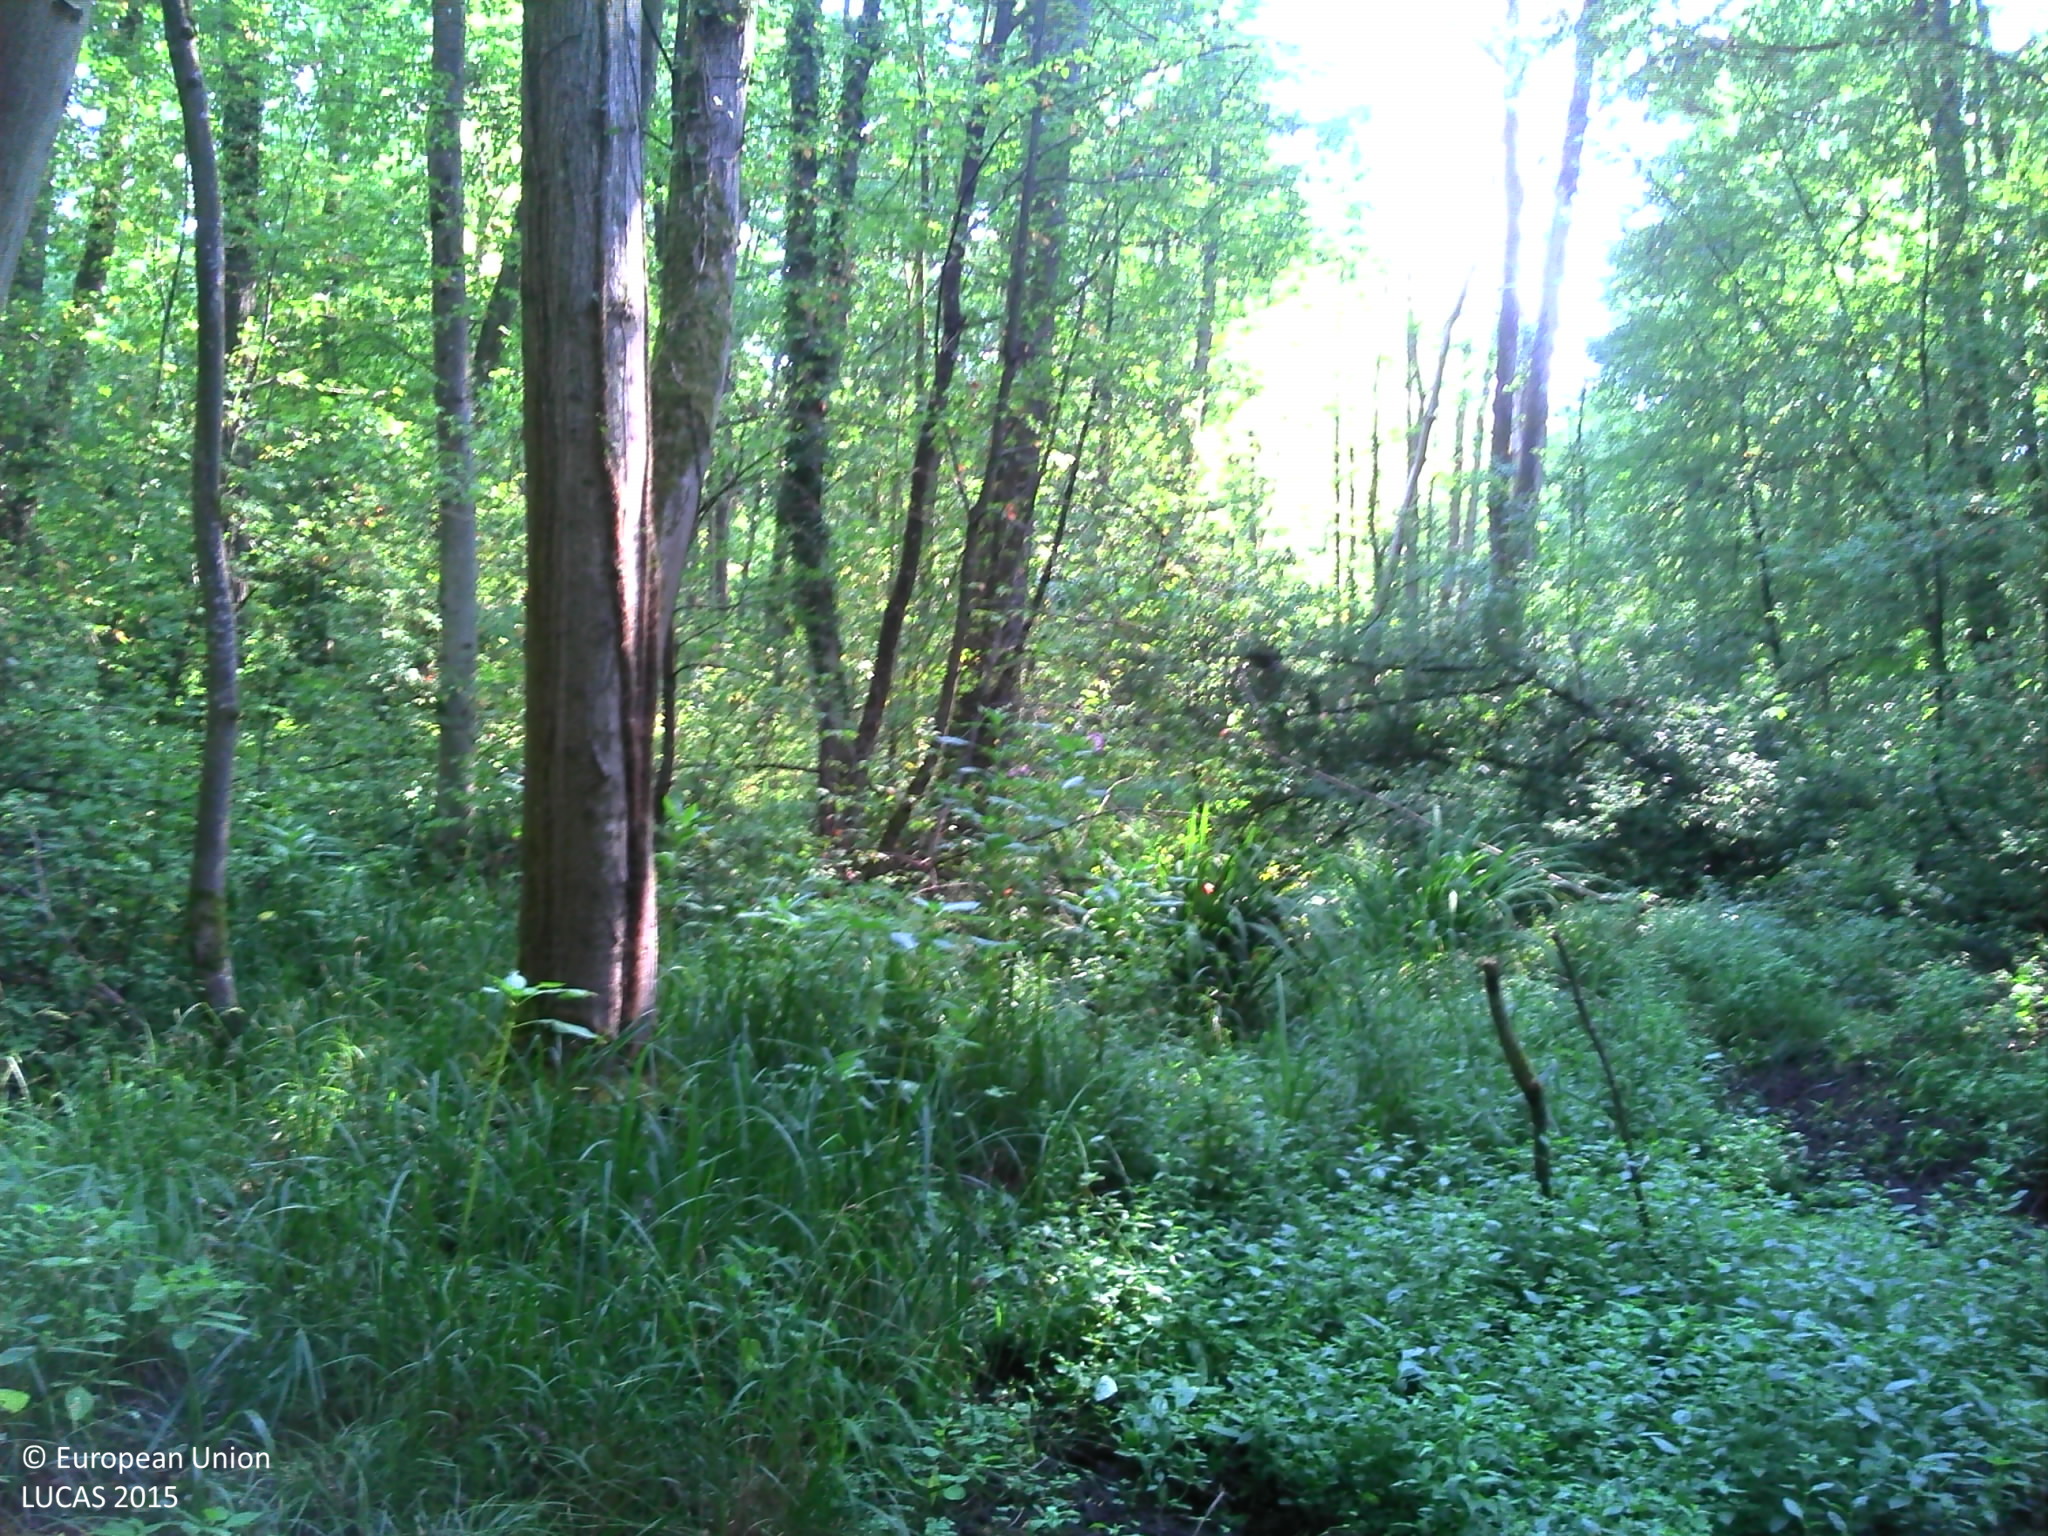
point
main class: Woodland
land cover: Broadleaved woodland
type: beech forest
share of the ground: > 75 %
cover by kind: broadleaved forest trees 95 %, herbaceous plants 5 %
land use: Semi-natural and natural areas not in use
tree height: > 5 m
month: August
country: FR
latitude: 48.8533
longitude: 7.9973
